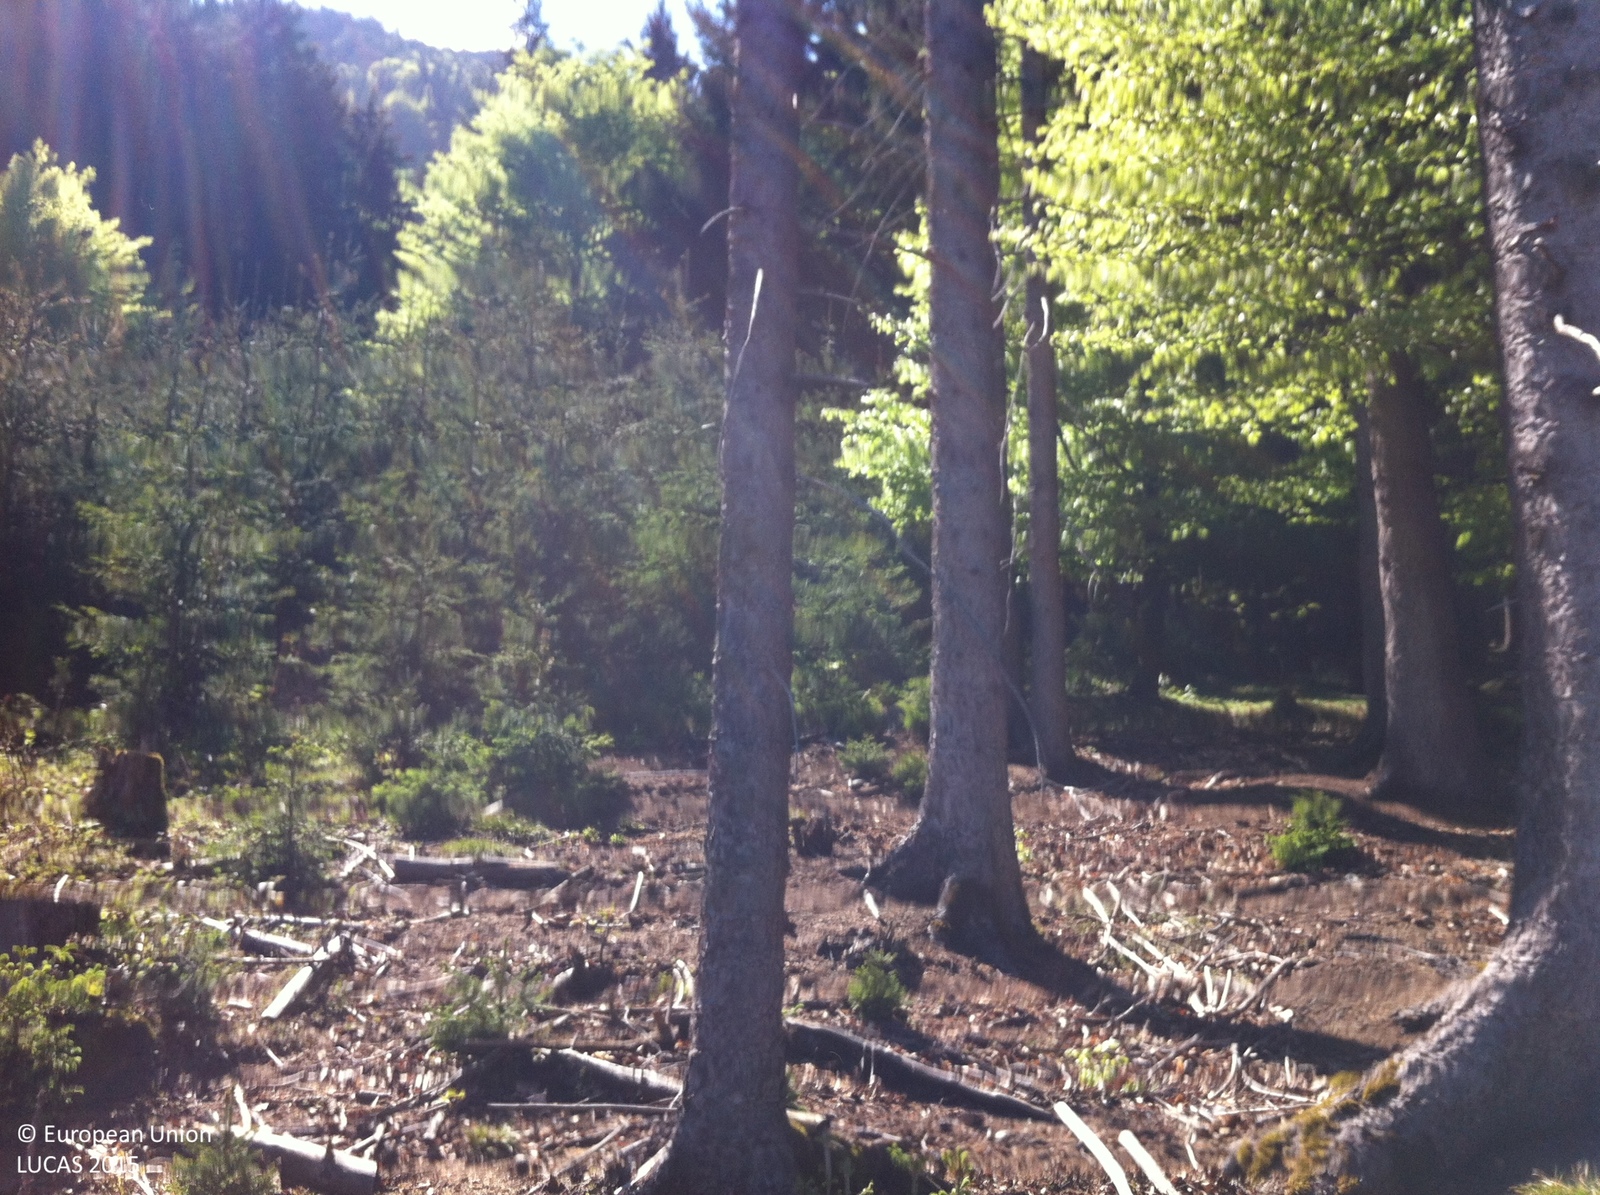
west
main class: Shrubland
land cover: Shrubland with sparse tree cover
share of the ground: > 75 %
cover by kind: unconsolidated bare surface 80 %, shrubs 10 %, coniferous forest trees 5 %, herbaceous plants 5 %
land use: Forestry
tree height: < 5 m
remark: Clear cut
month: May
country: AT
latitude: 47.3994
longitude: 11.7608
